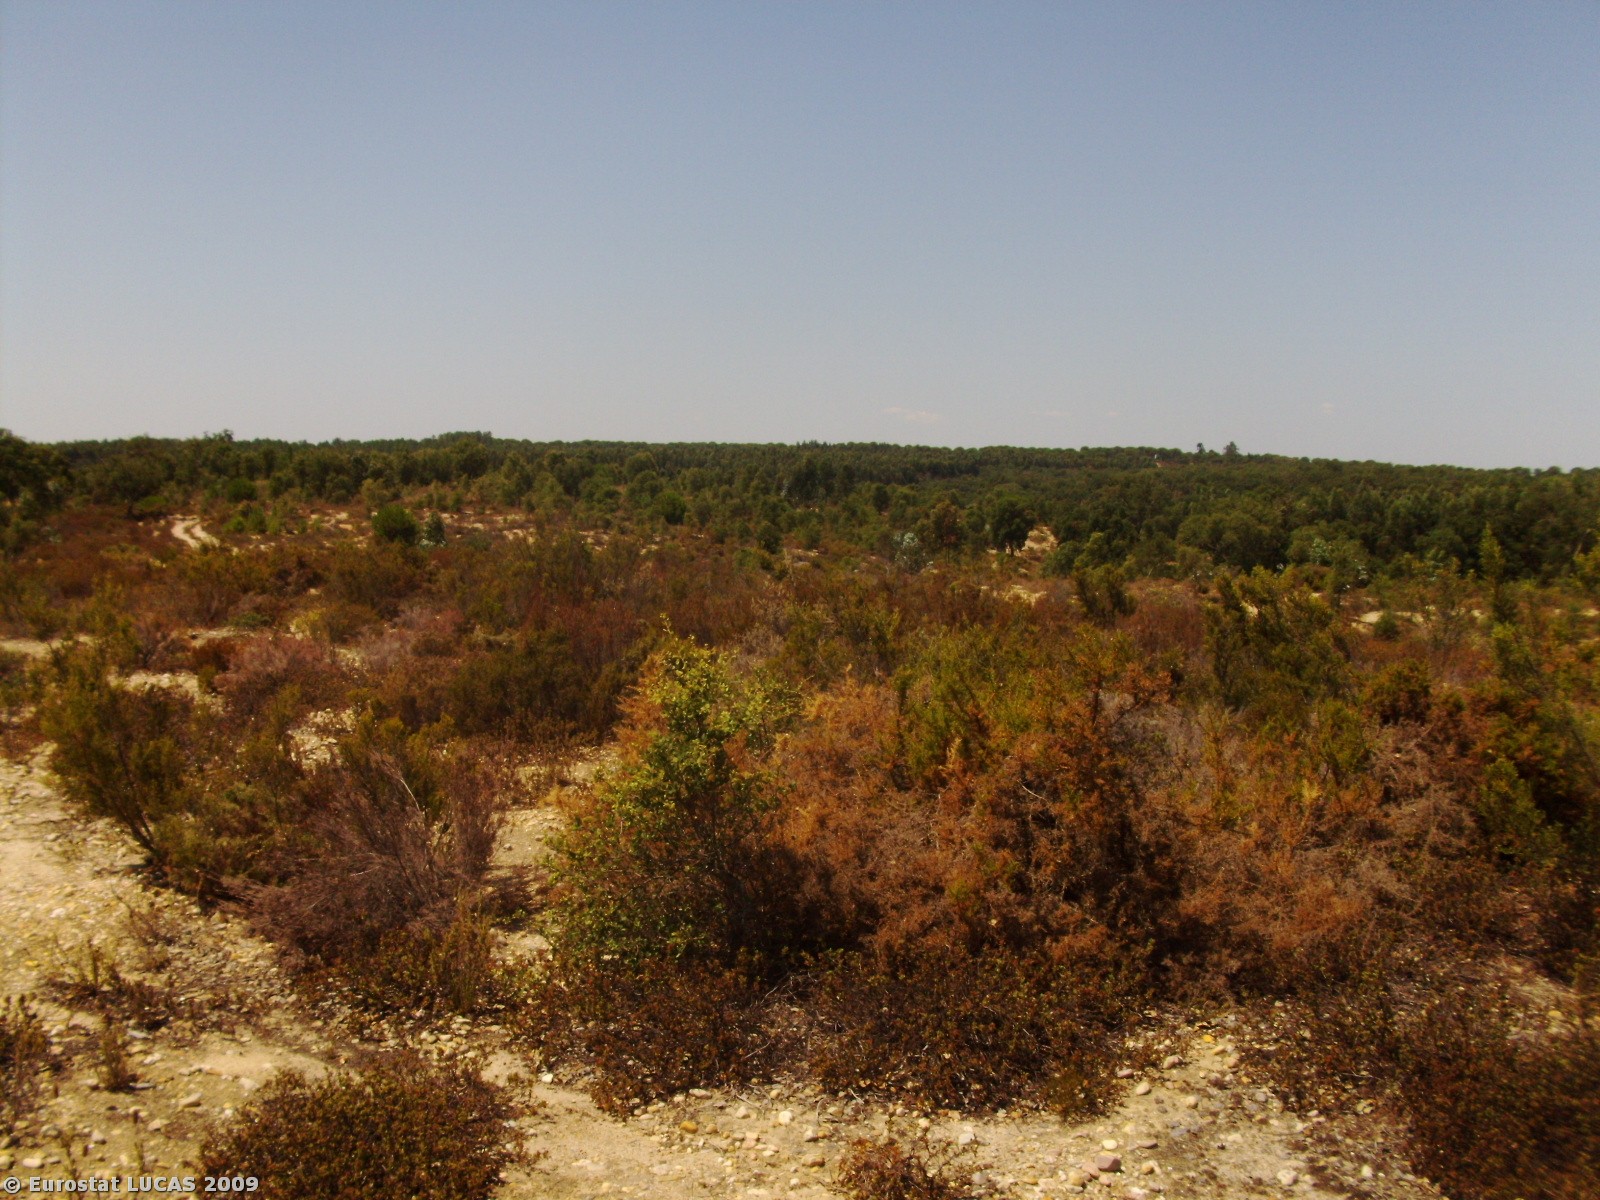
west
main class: Woodland
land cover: Mixed woodland
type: hemiboreal forest and nemoral coniferous forest and mixed broadleaved-coniferous forest
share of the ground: 10 - 25 %
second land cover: Spontaneously vegetated surfaces
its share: 50 - 75 %
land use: Forestry
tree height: > 5 m
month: August
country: PT
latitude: 39.2345
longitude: -8.0946
